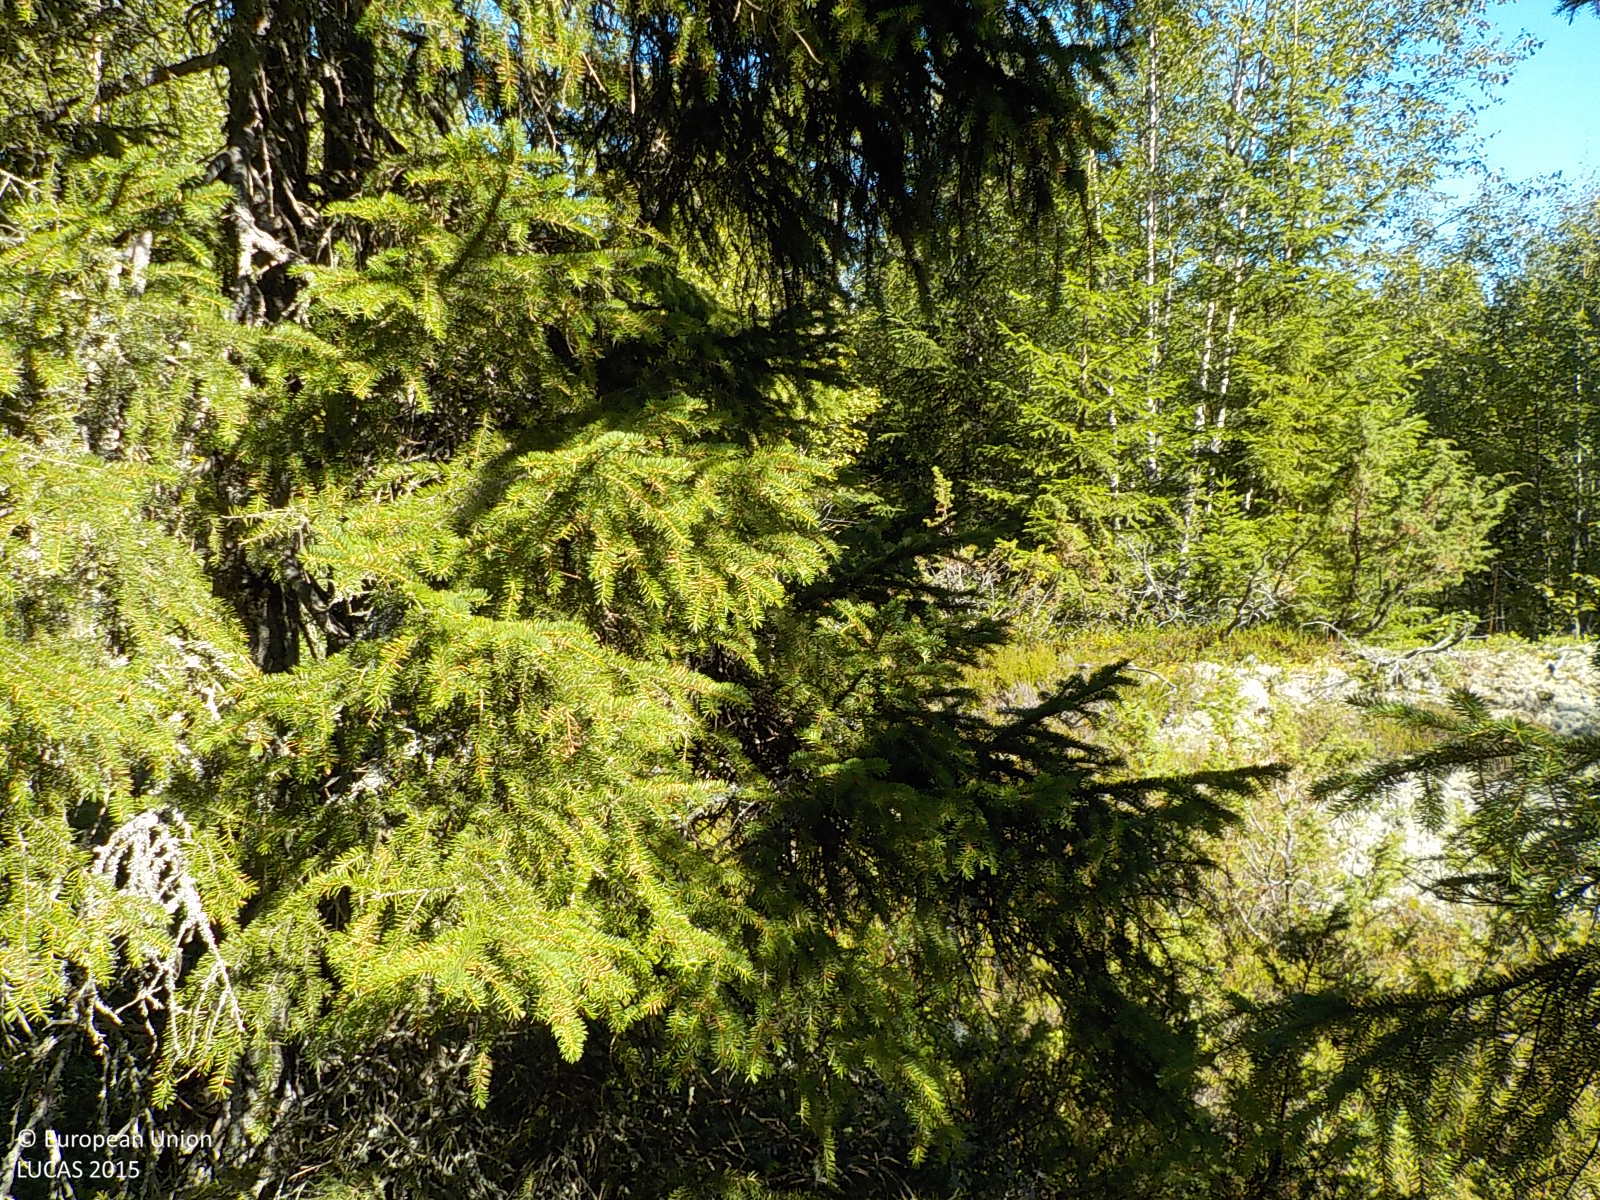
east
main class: Woodland
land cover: Spruce dominated mixed woodland
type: boreal forest
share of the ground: > 75 %
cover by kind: coniferous forest trees 60 %, broadleaved forest trees 20 %, herbaceous plants 20 %
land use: Forestry
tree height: > 5 m
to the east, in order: Spruce dominated mixed woodland; Grassland without tree/shrub cover; Broadleaved woodland; Pine dominated mixed woodland; Broadleaved woodland; Electric lines; Broadleaved woodland; Other mixed woodland
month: August
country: SE
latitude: 63.3408
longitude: 18.7077
